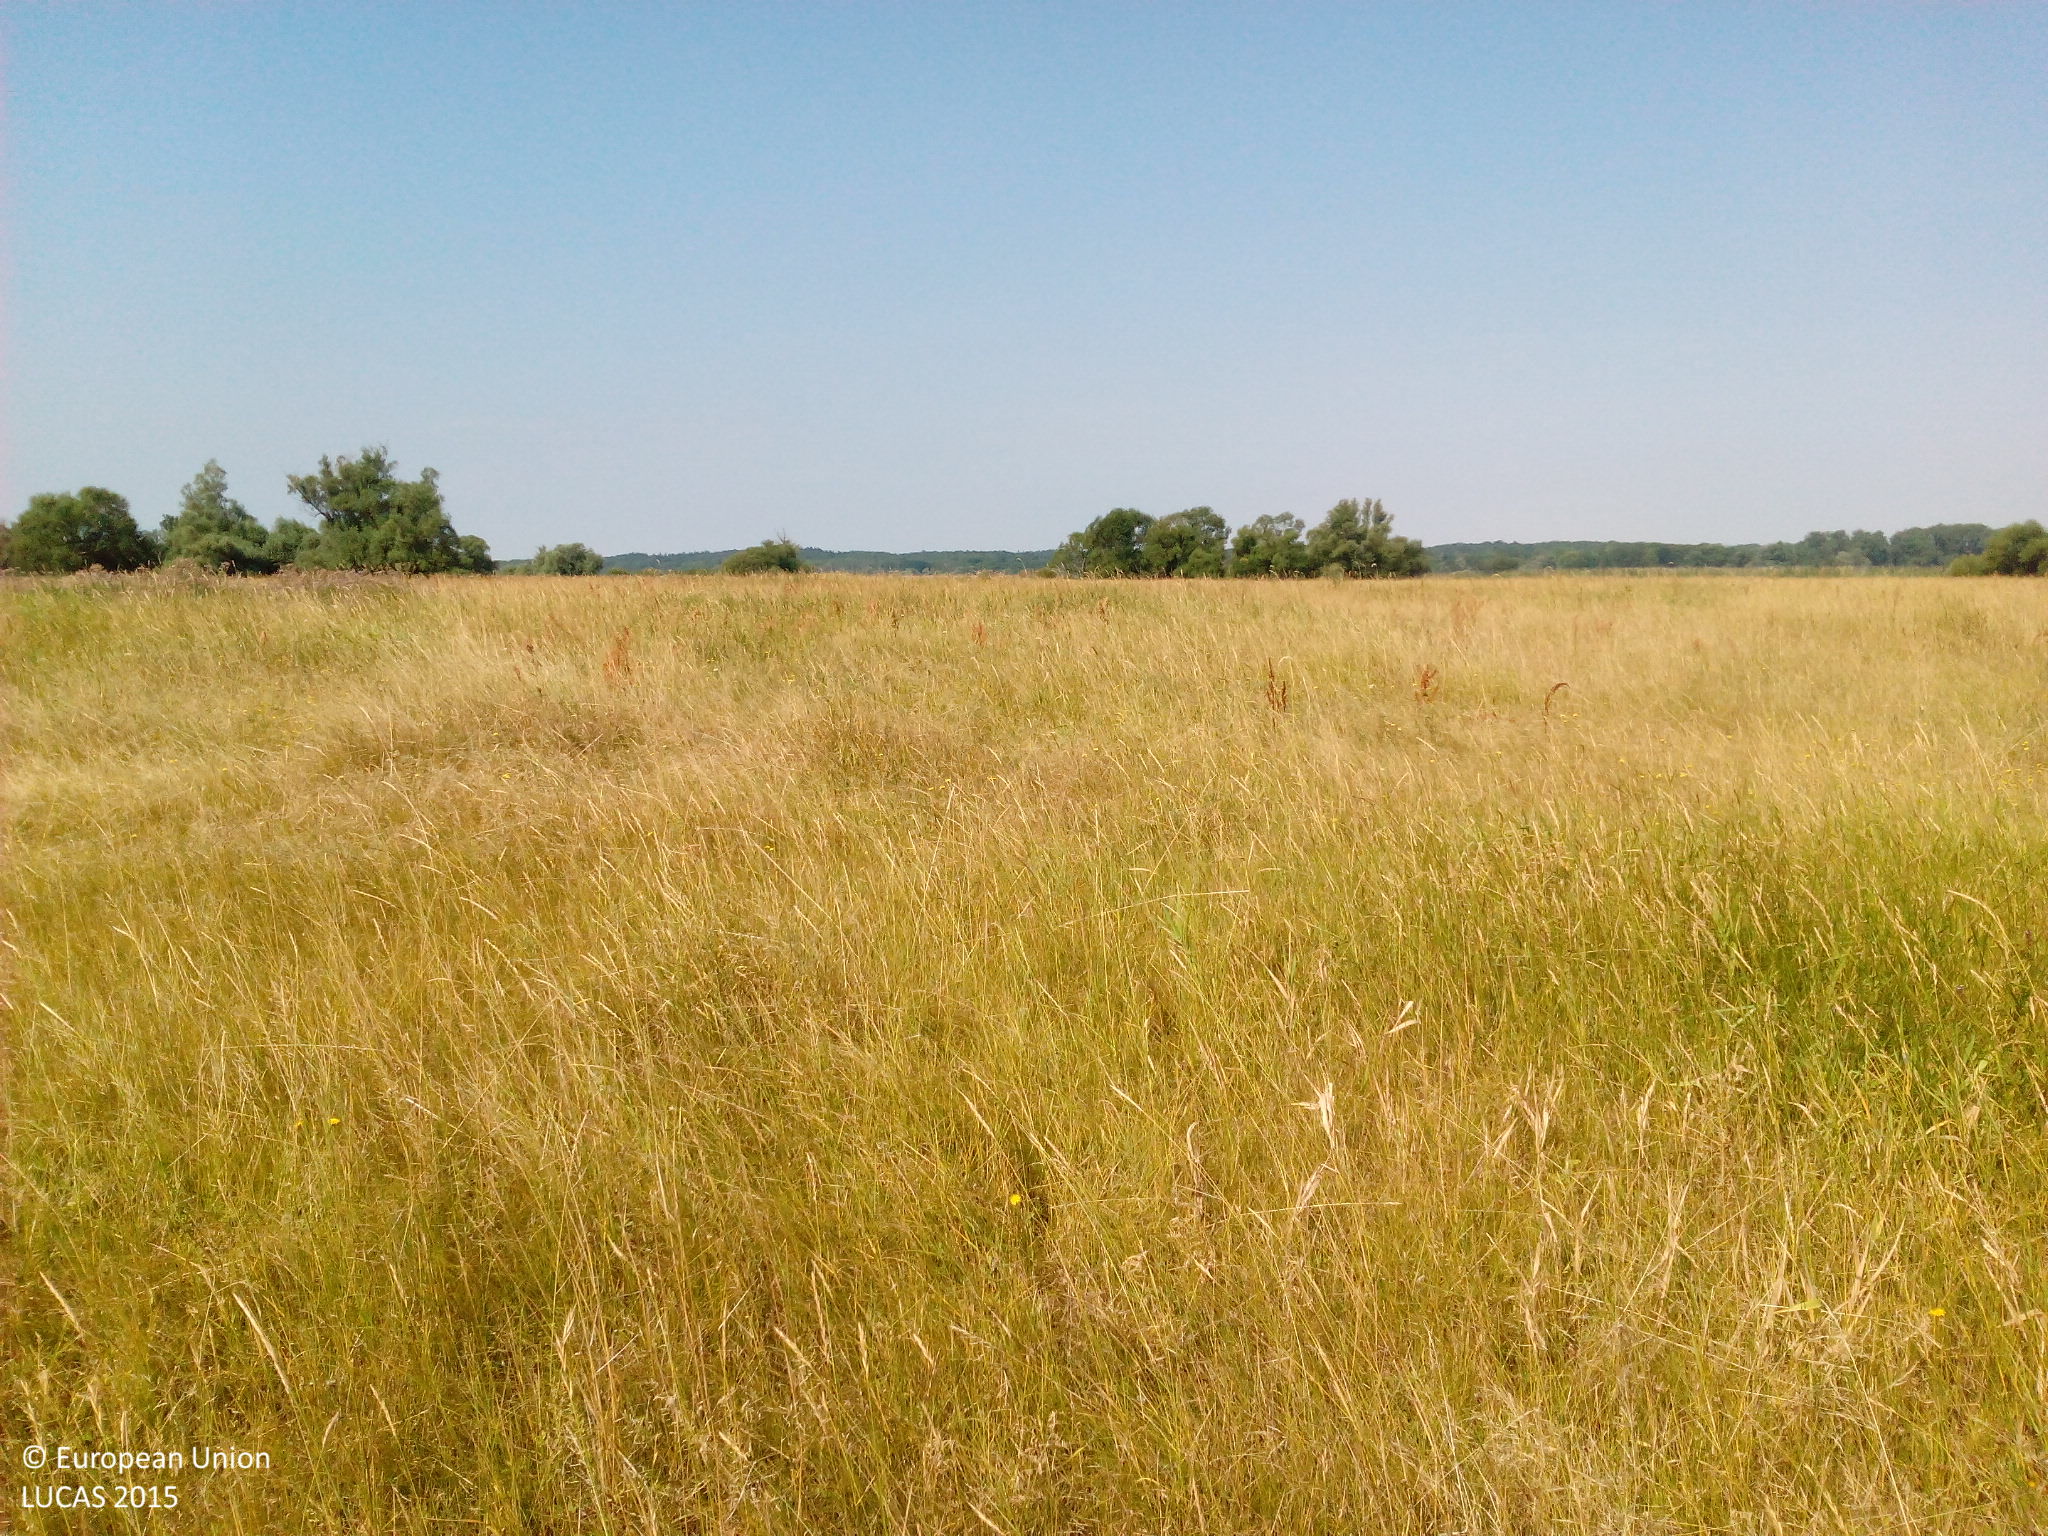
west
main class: Grassland
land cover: Grassland without tree/shrub cover
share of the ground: > 75 %
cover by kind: herbaceous plants 100 %
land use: Semi-natural and natural areas not in use
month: August
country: DE
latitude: 53.0035
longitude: 14.2479
